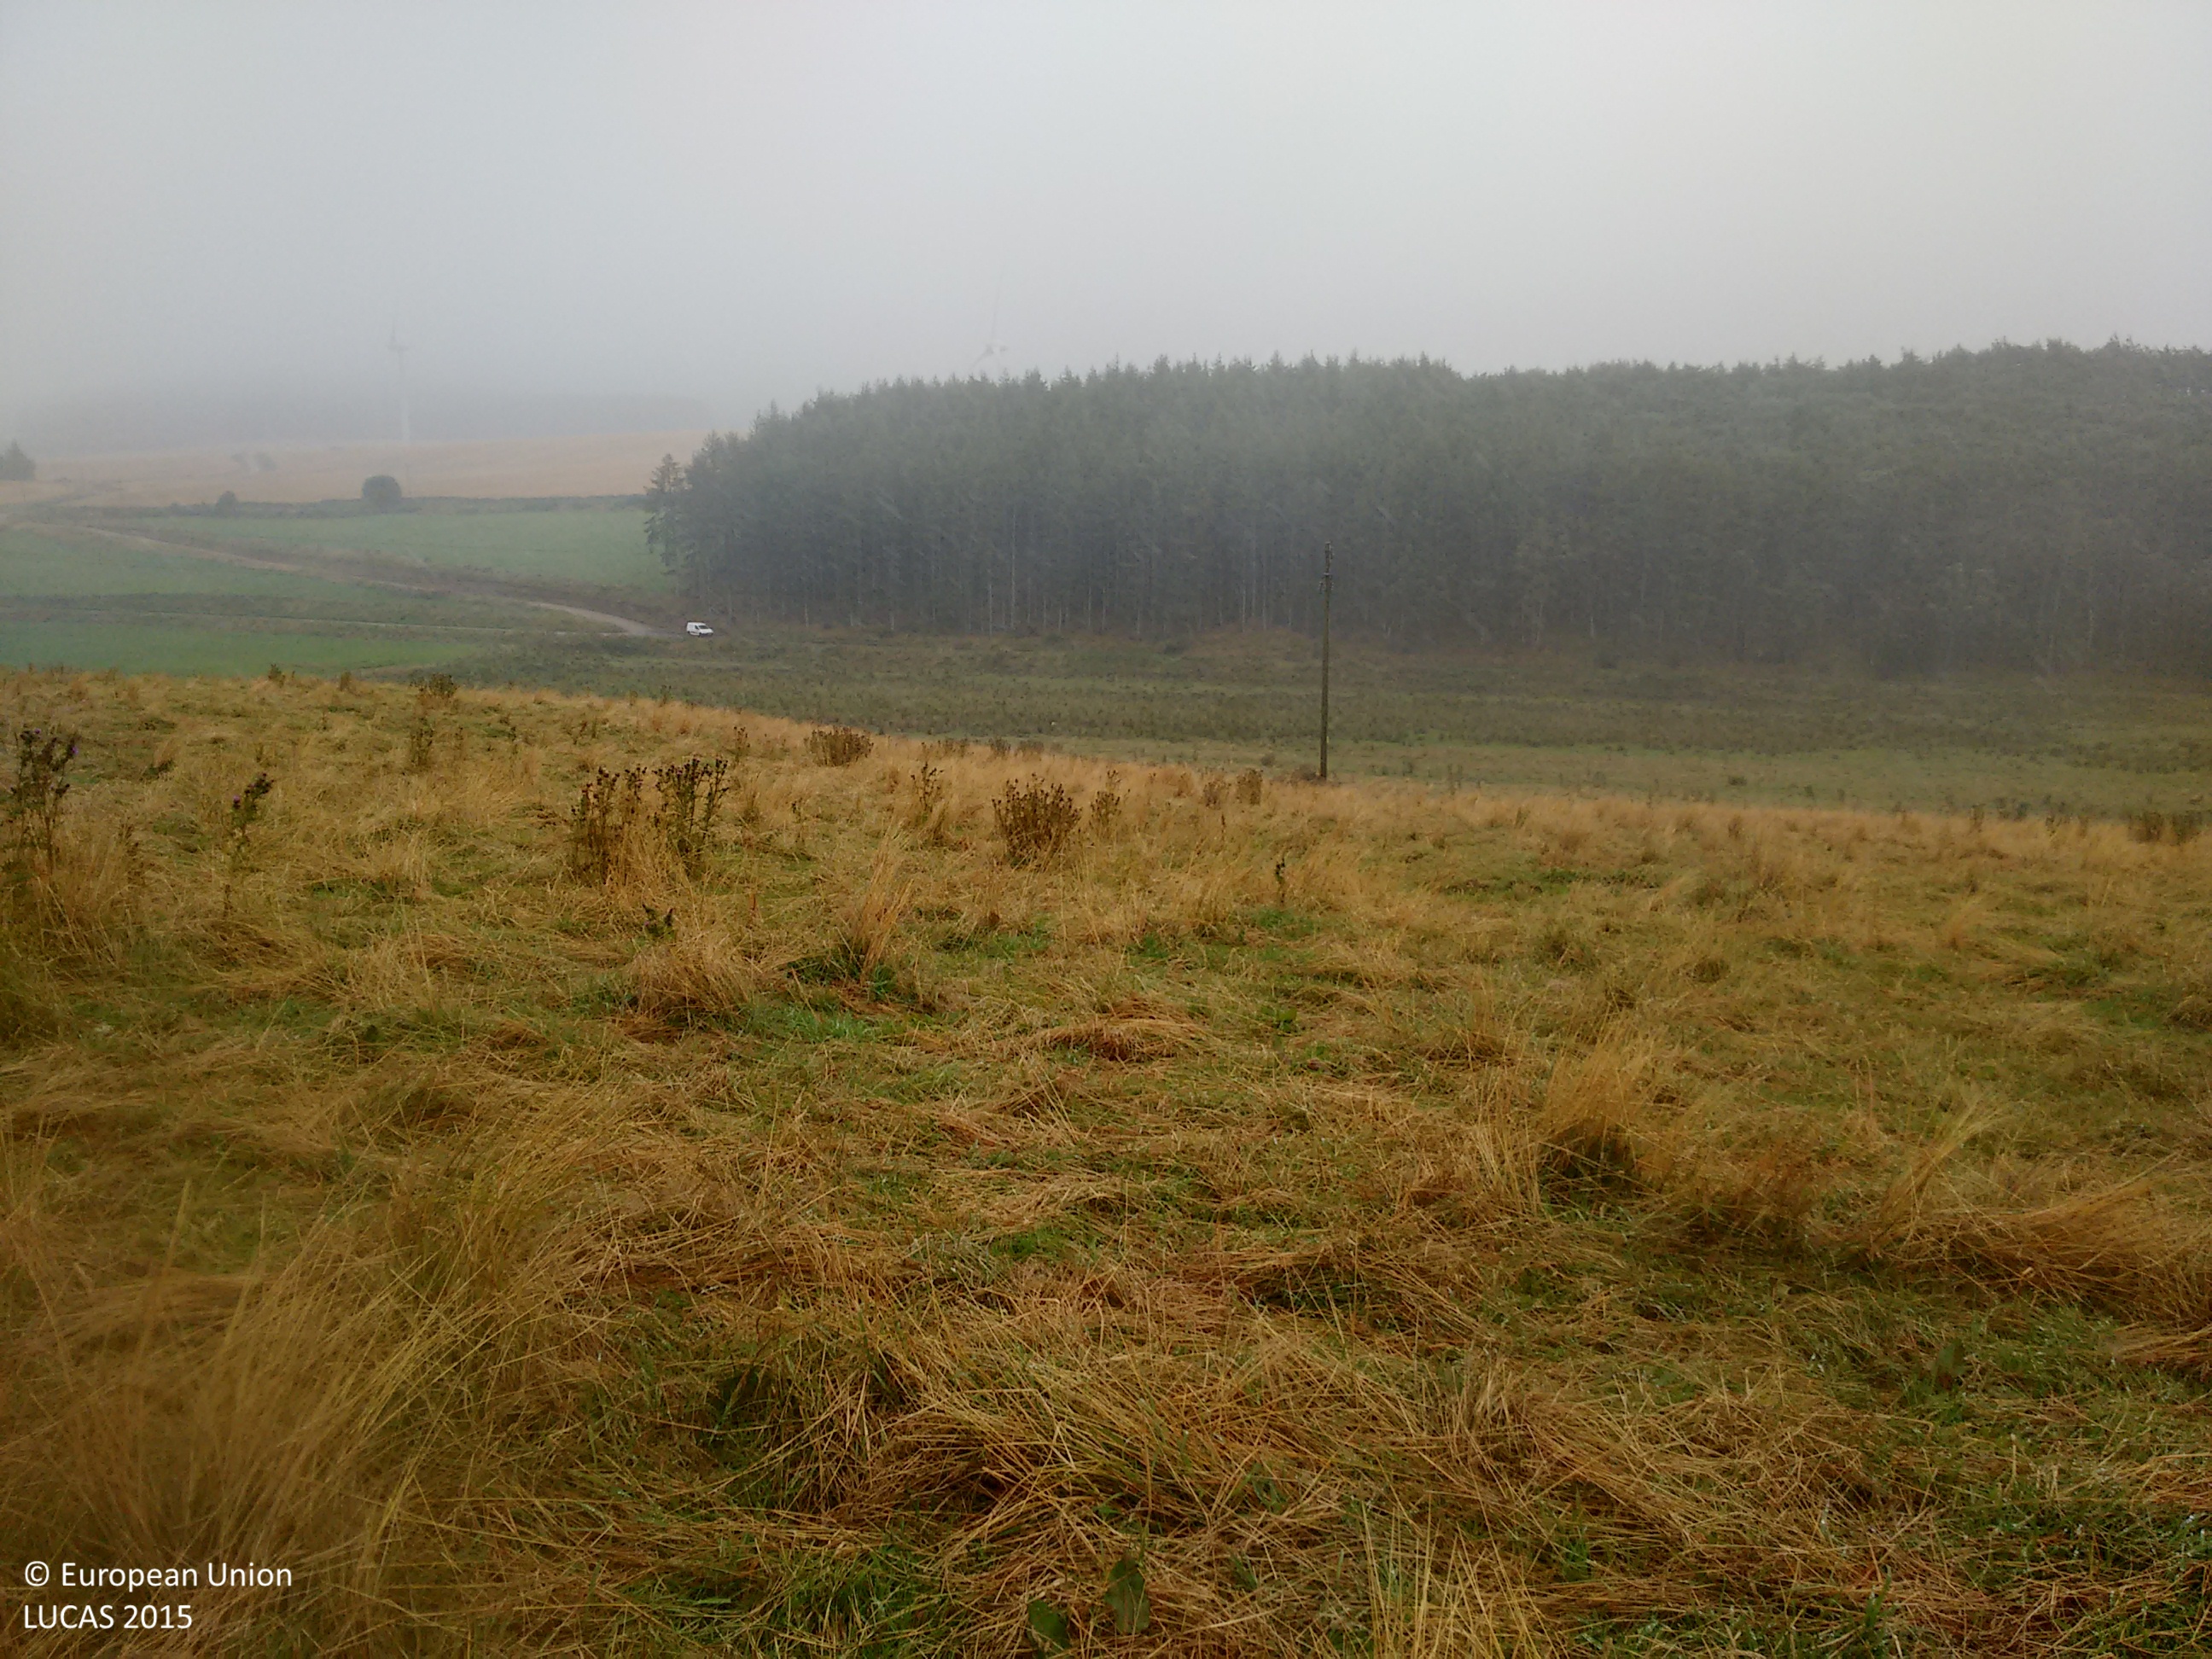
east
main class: Grassland
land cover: Grassland without tree/shrub cover
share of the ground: > 75 %
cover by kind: herbaceous plants 100 %
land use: Agriculture (excluding fallow land and kitchen gardens)
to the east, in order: Grassland without tree/shrub cover; Electric lines; Grassland without tree/shrub cover; Fences; Shruby margins; Paved roads, cycling and walking lanes; Grass margins; Ditches and canals; Other coniferous woodland
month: September
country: GB
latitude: 57.5985
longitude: -2.8584
